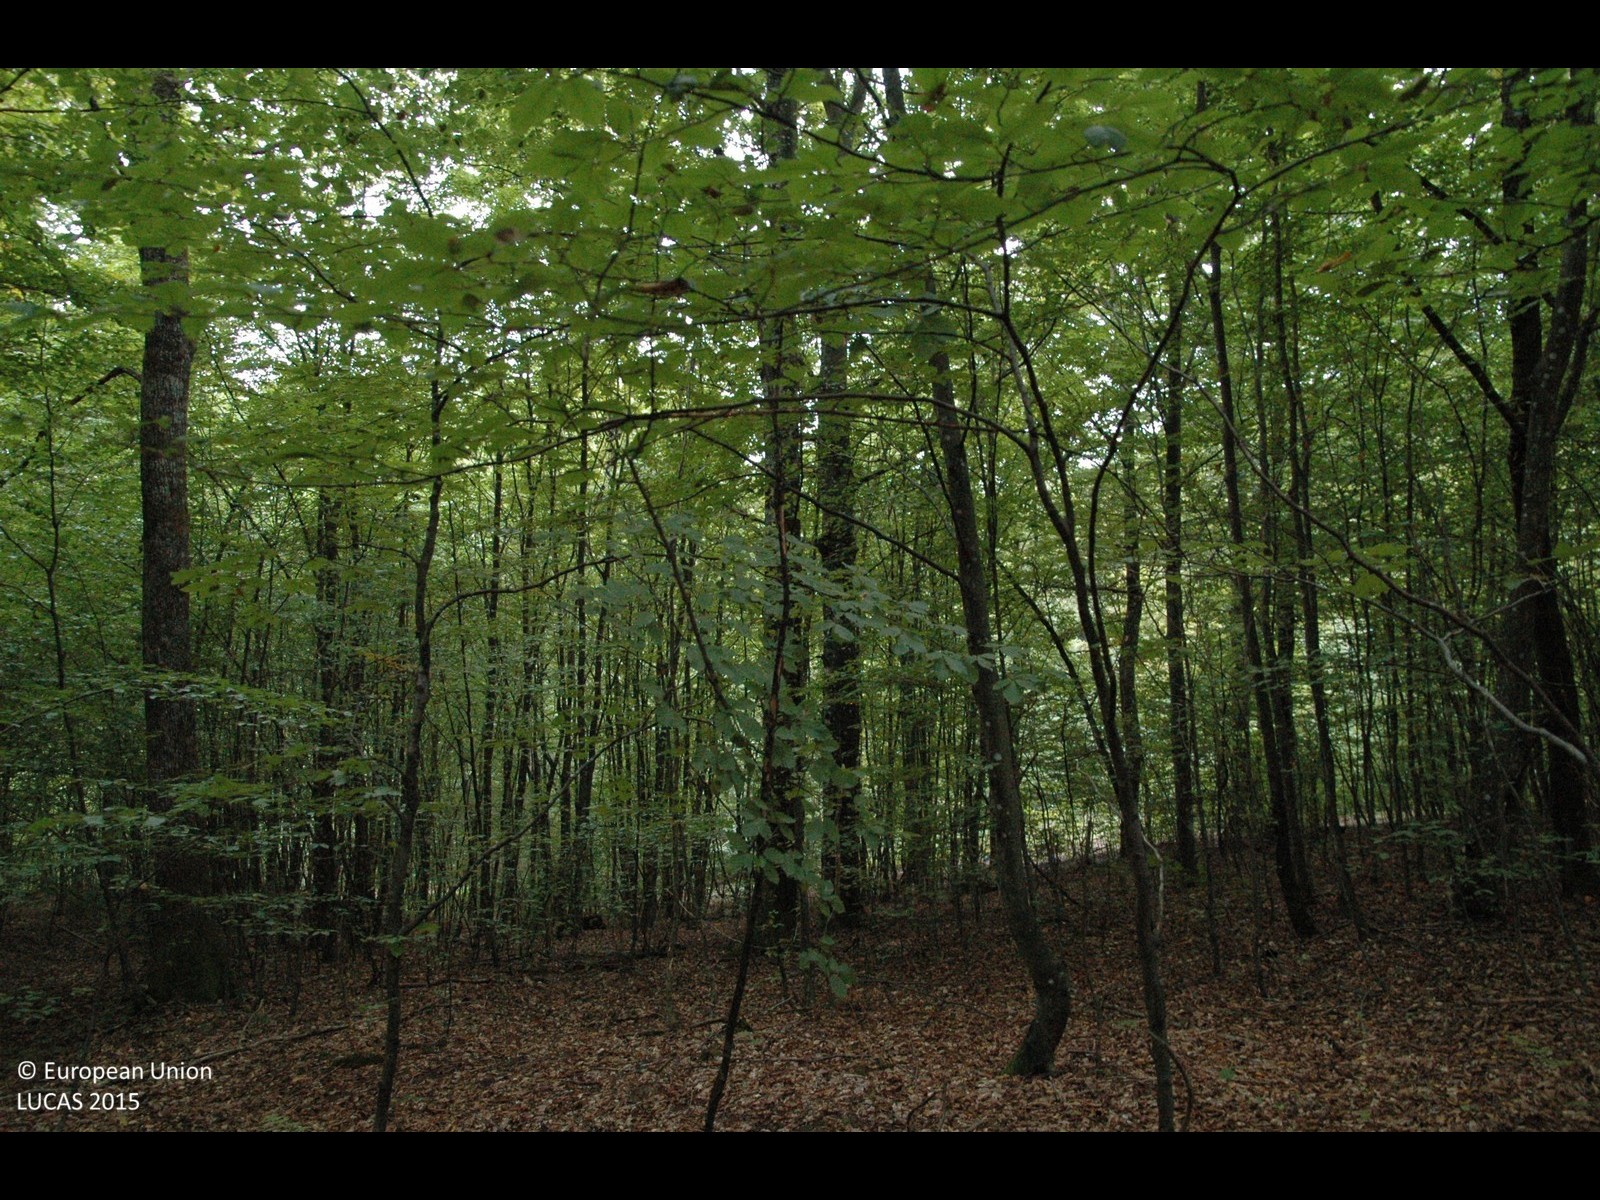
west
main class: Woodland
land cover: Broadleaved woodland
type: mesophytic deciduous forest
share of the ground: > 75 %
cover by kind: broadleaved forest trees 100 %
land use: Forestry
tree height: > 5 m
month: October
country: HR
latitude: 45.5804
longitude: 16.1107
